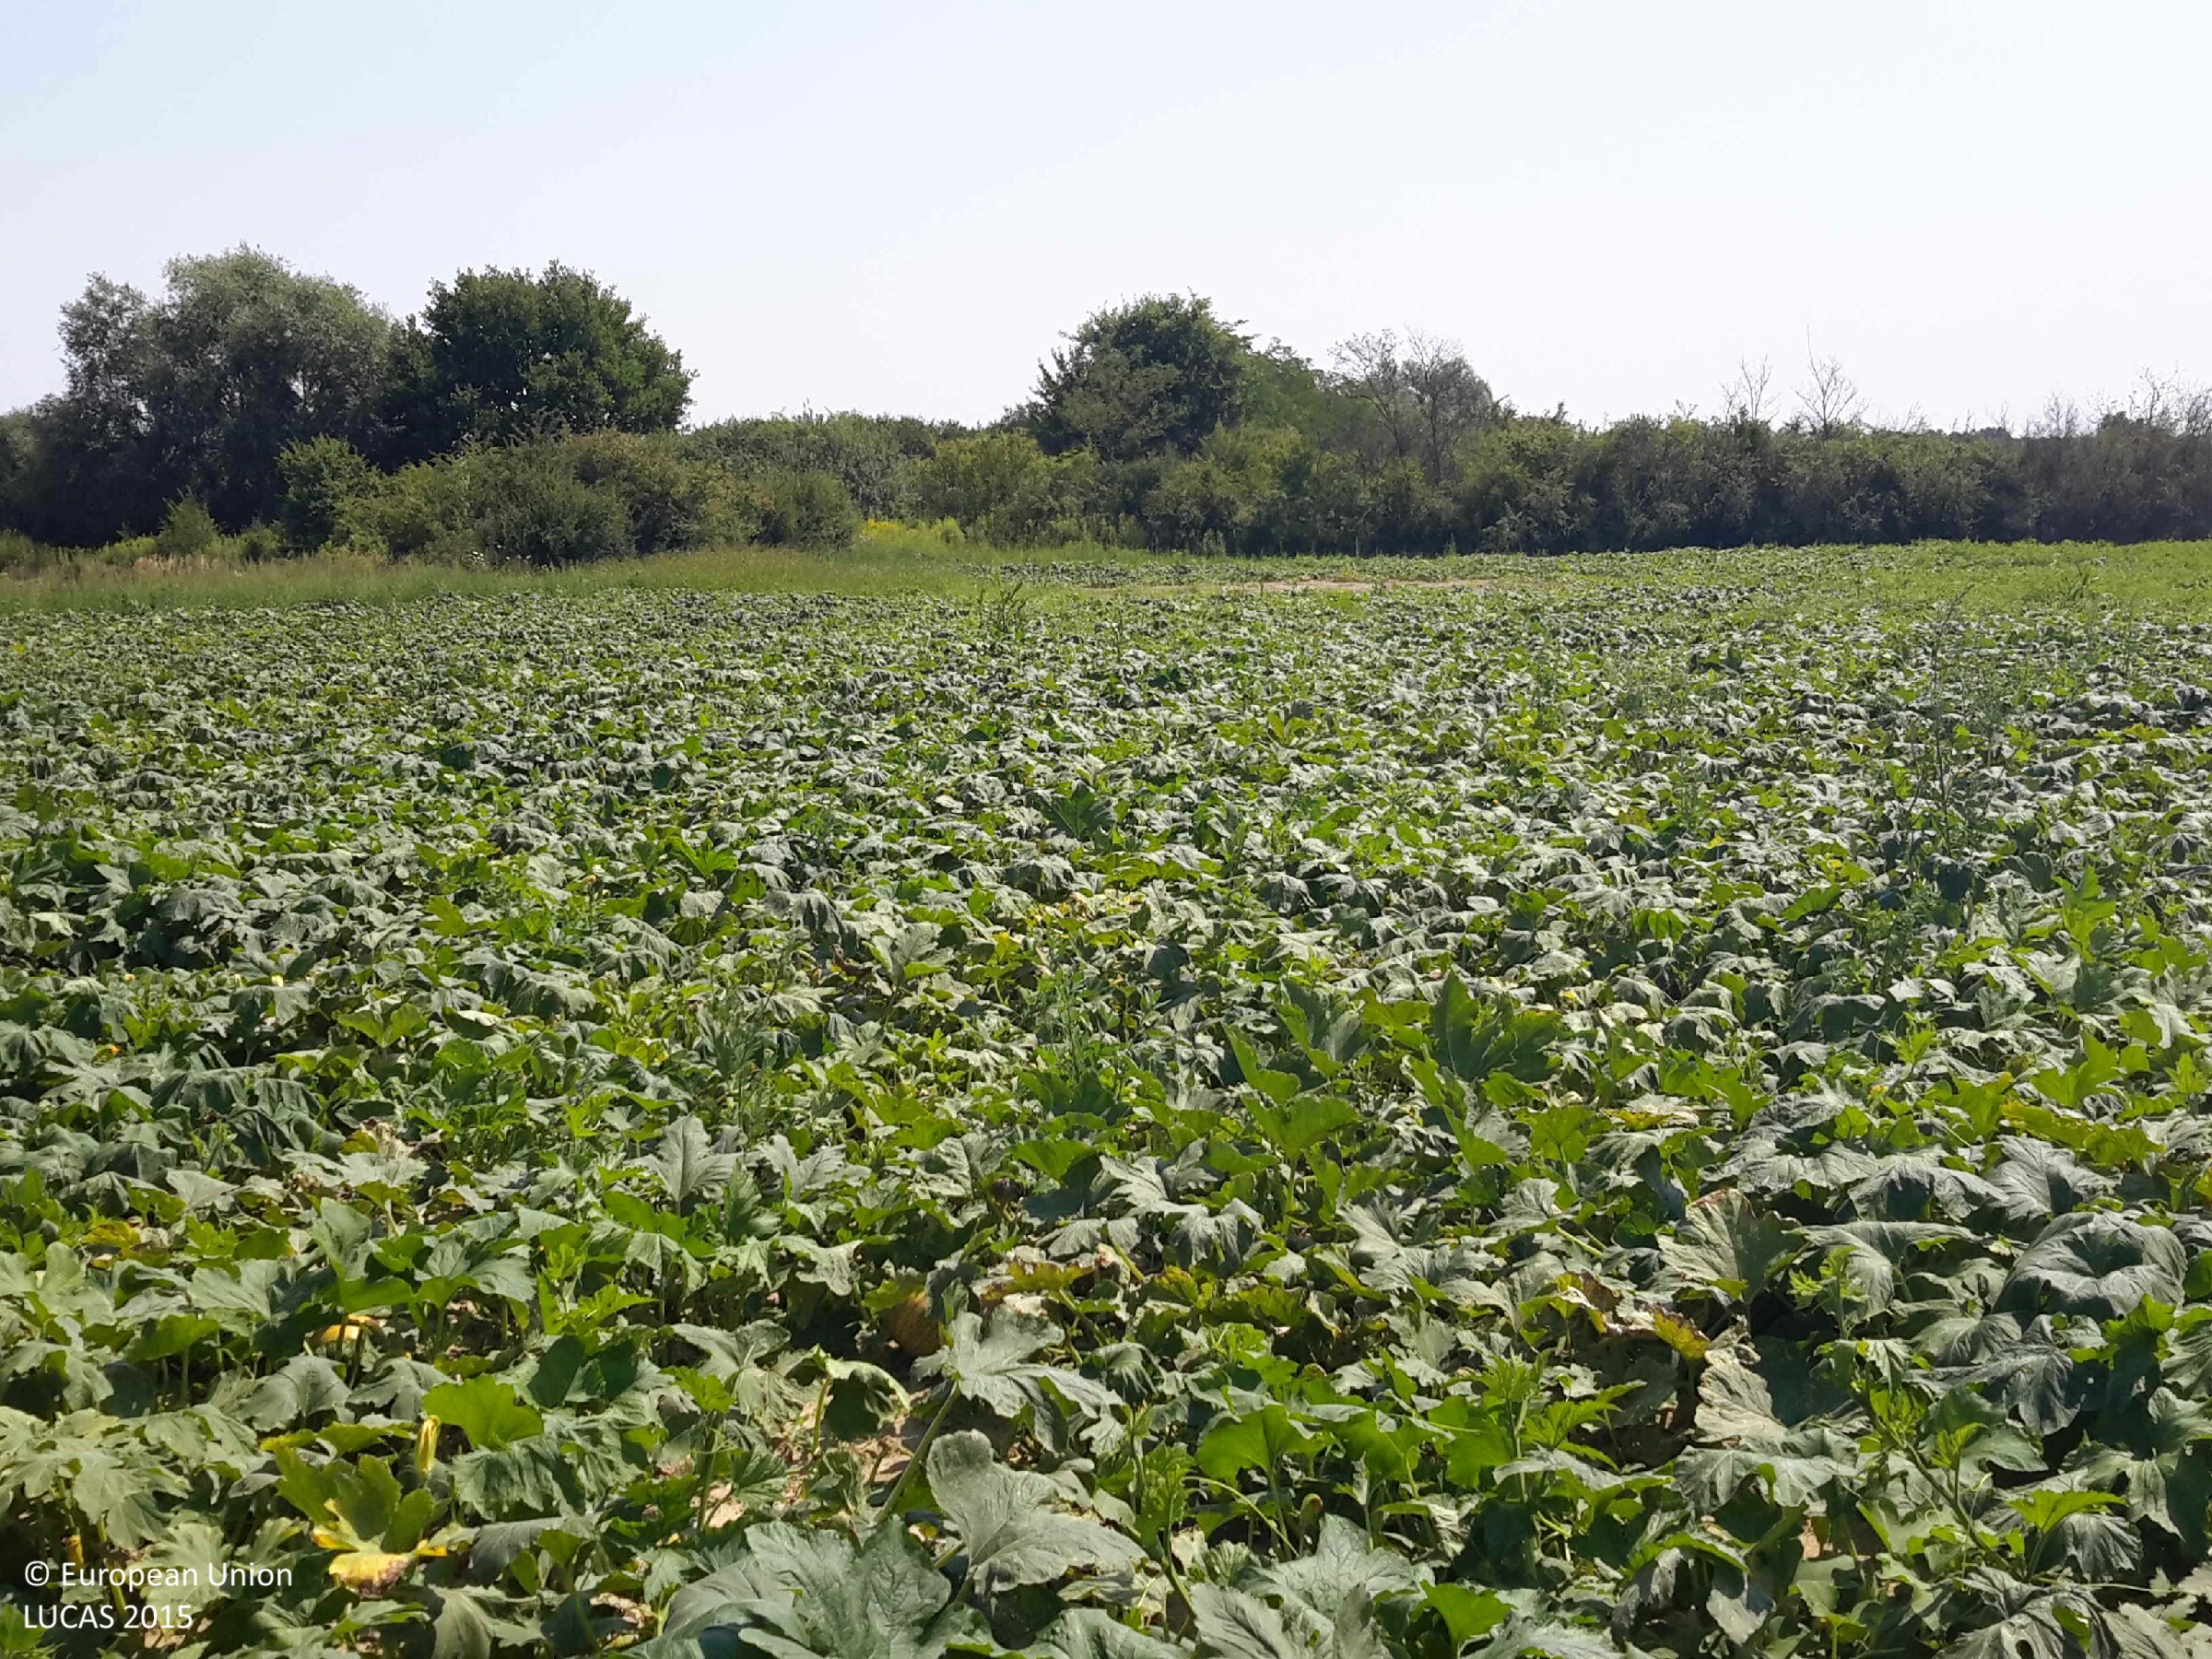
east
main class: Cropland
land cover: Other fibre and oleaginous crops
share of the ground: > 75 %
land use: Agriculture (excluding fallow land and kitchen gardens)
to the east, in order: Other fibre and oleaginous crops; Abandoned hedges; Ditches and canals; Abandoned hedges; Tracks; Abandoned hedges; Ditches and canals; Abandoned hedges; Maize; Abandoned hedges; Grass margins; Other fruit trees and berries
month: July
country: HU
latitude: 47.1192
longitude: 16.6595
